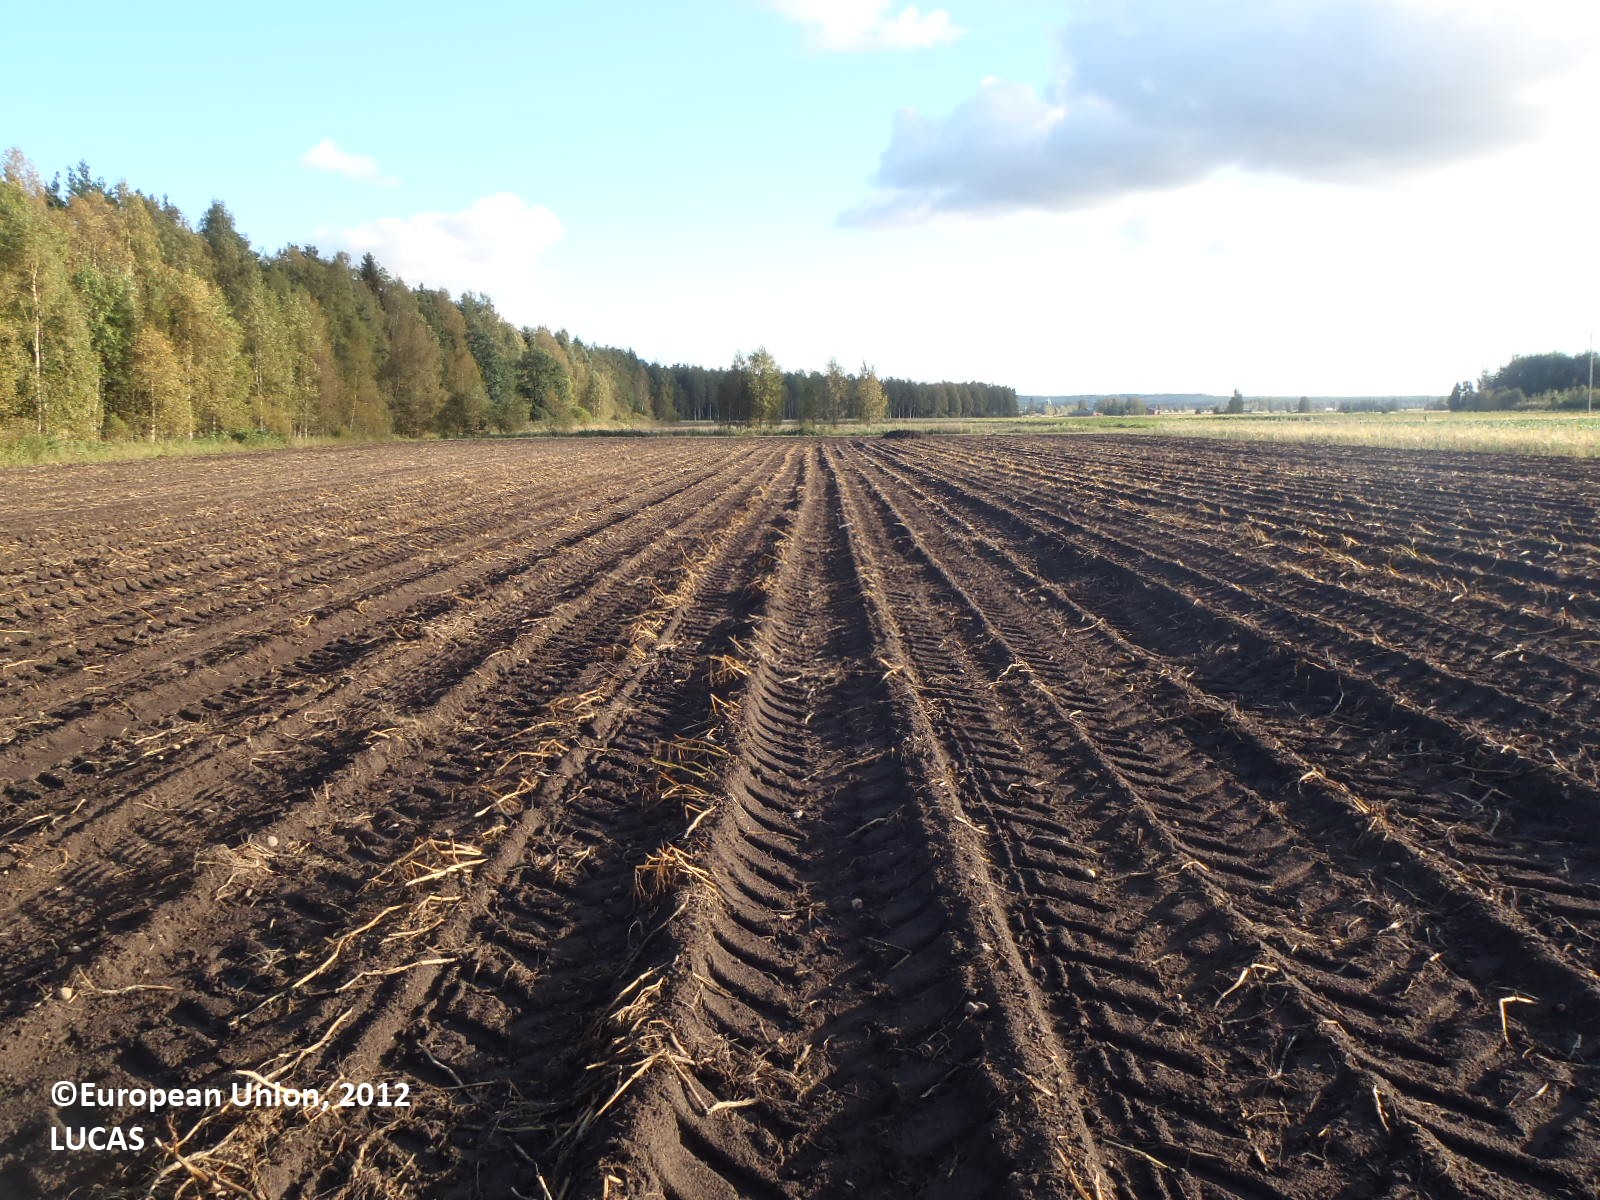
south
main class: Cropland
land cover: Potatoes
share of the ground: > 75 %
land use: Agriculture (excluding fallow land and kitchen gardens)
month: September
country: FI
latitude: 61.0796
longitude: 22.5426
